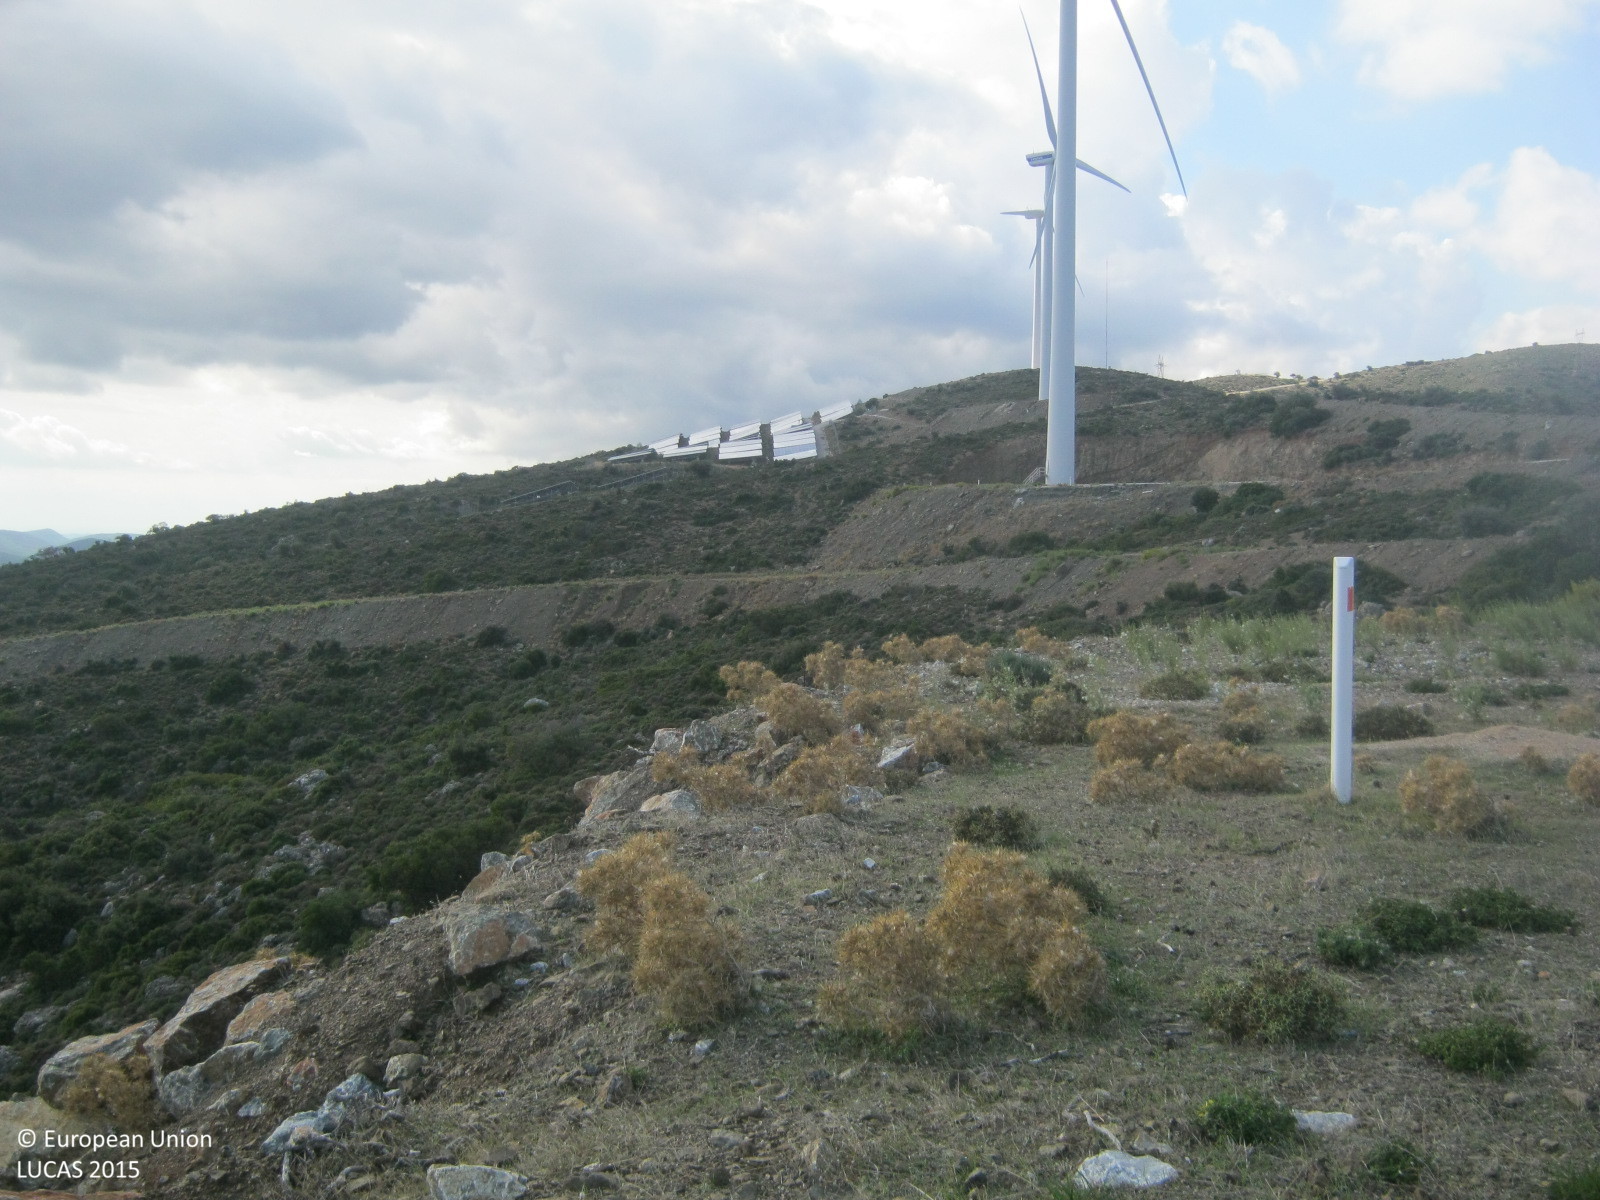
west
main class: Shrubland
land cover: Shrubland without tree cover
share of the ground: > 75 %
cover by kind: shrubs 90 %, unconsolidated bare surface 10 %
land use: Semi-natural and natural areas not in use
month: October
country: GR
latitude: 37.4664
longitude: 23.3216
